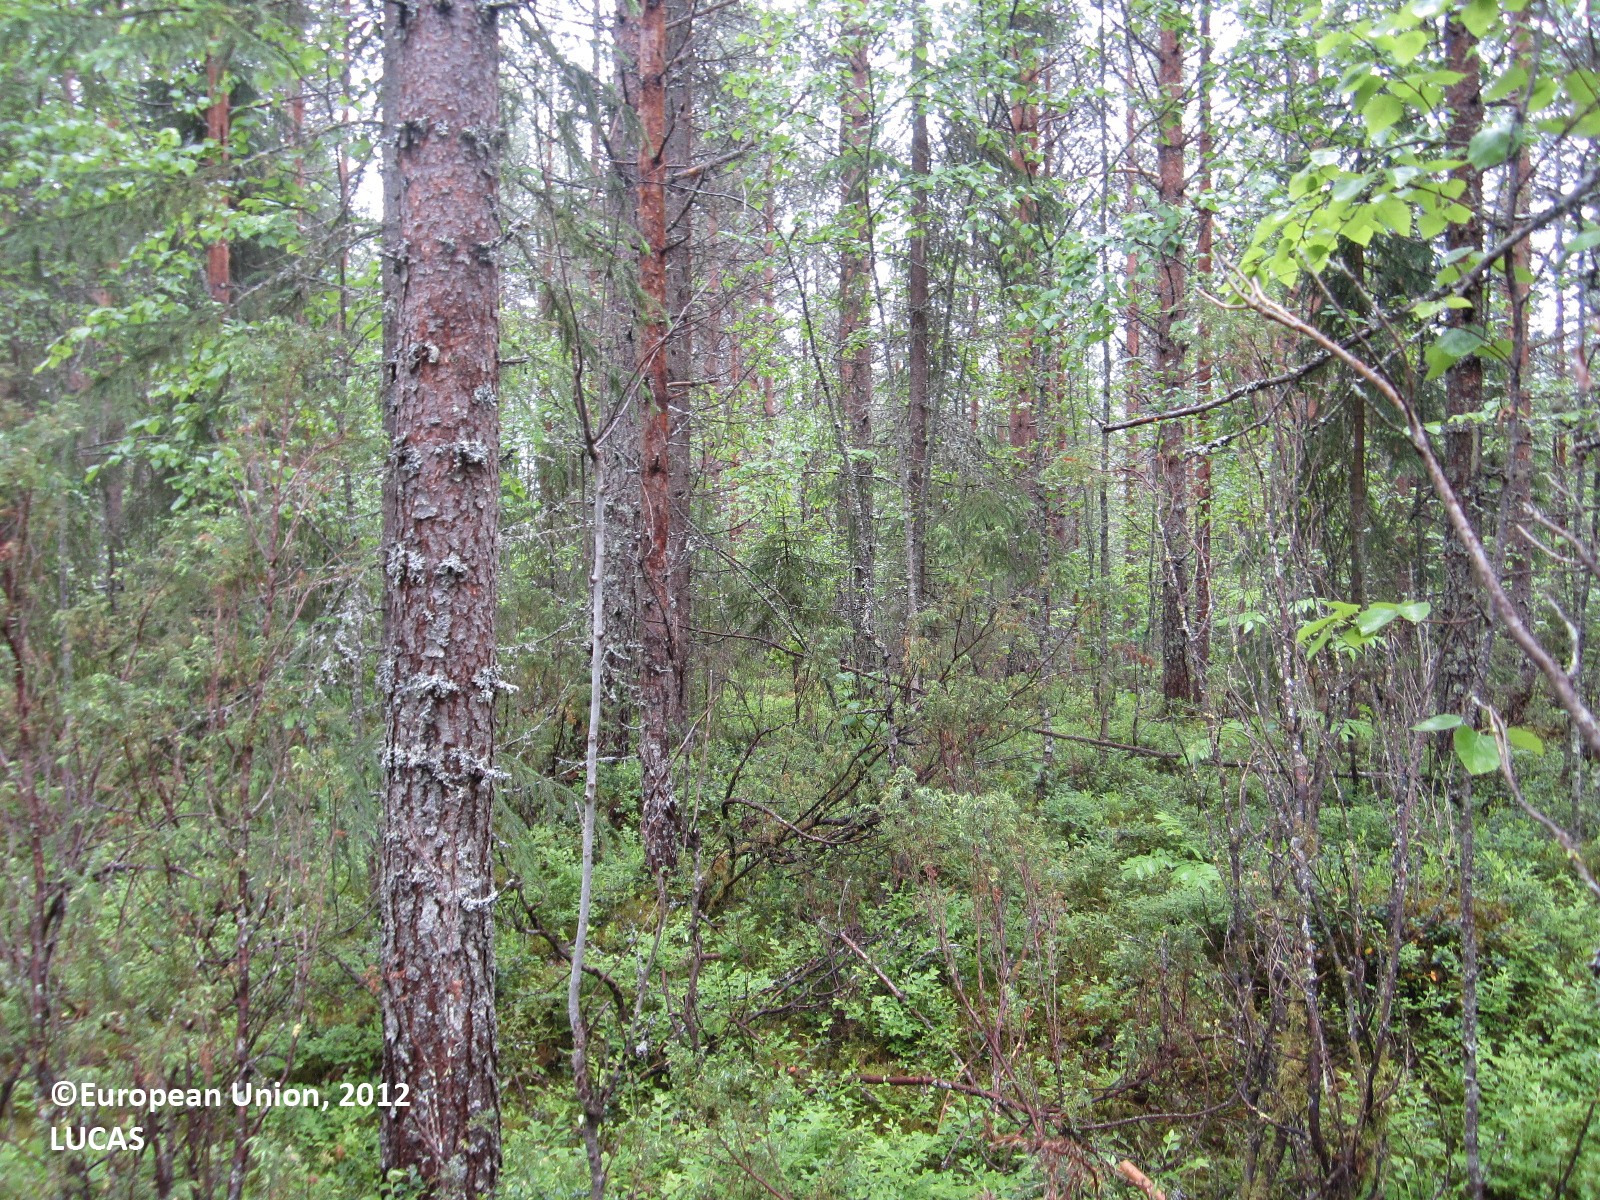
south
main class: Woodland
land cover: Pine dominated mixed woodland
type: boreal forest
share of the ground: > 75 %
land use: Forestry
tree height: > 5 m
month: June
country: FI
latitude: 64.5089
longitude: 29.8664
